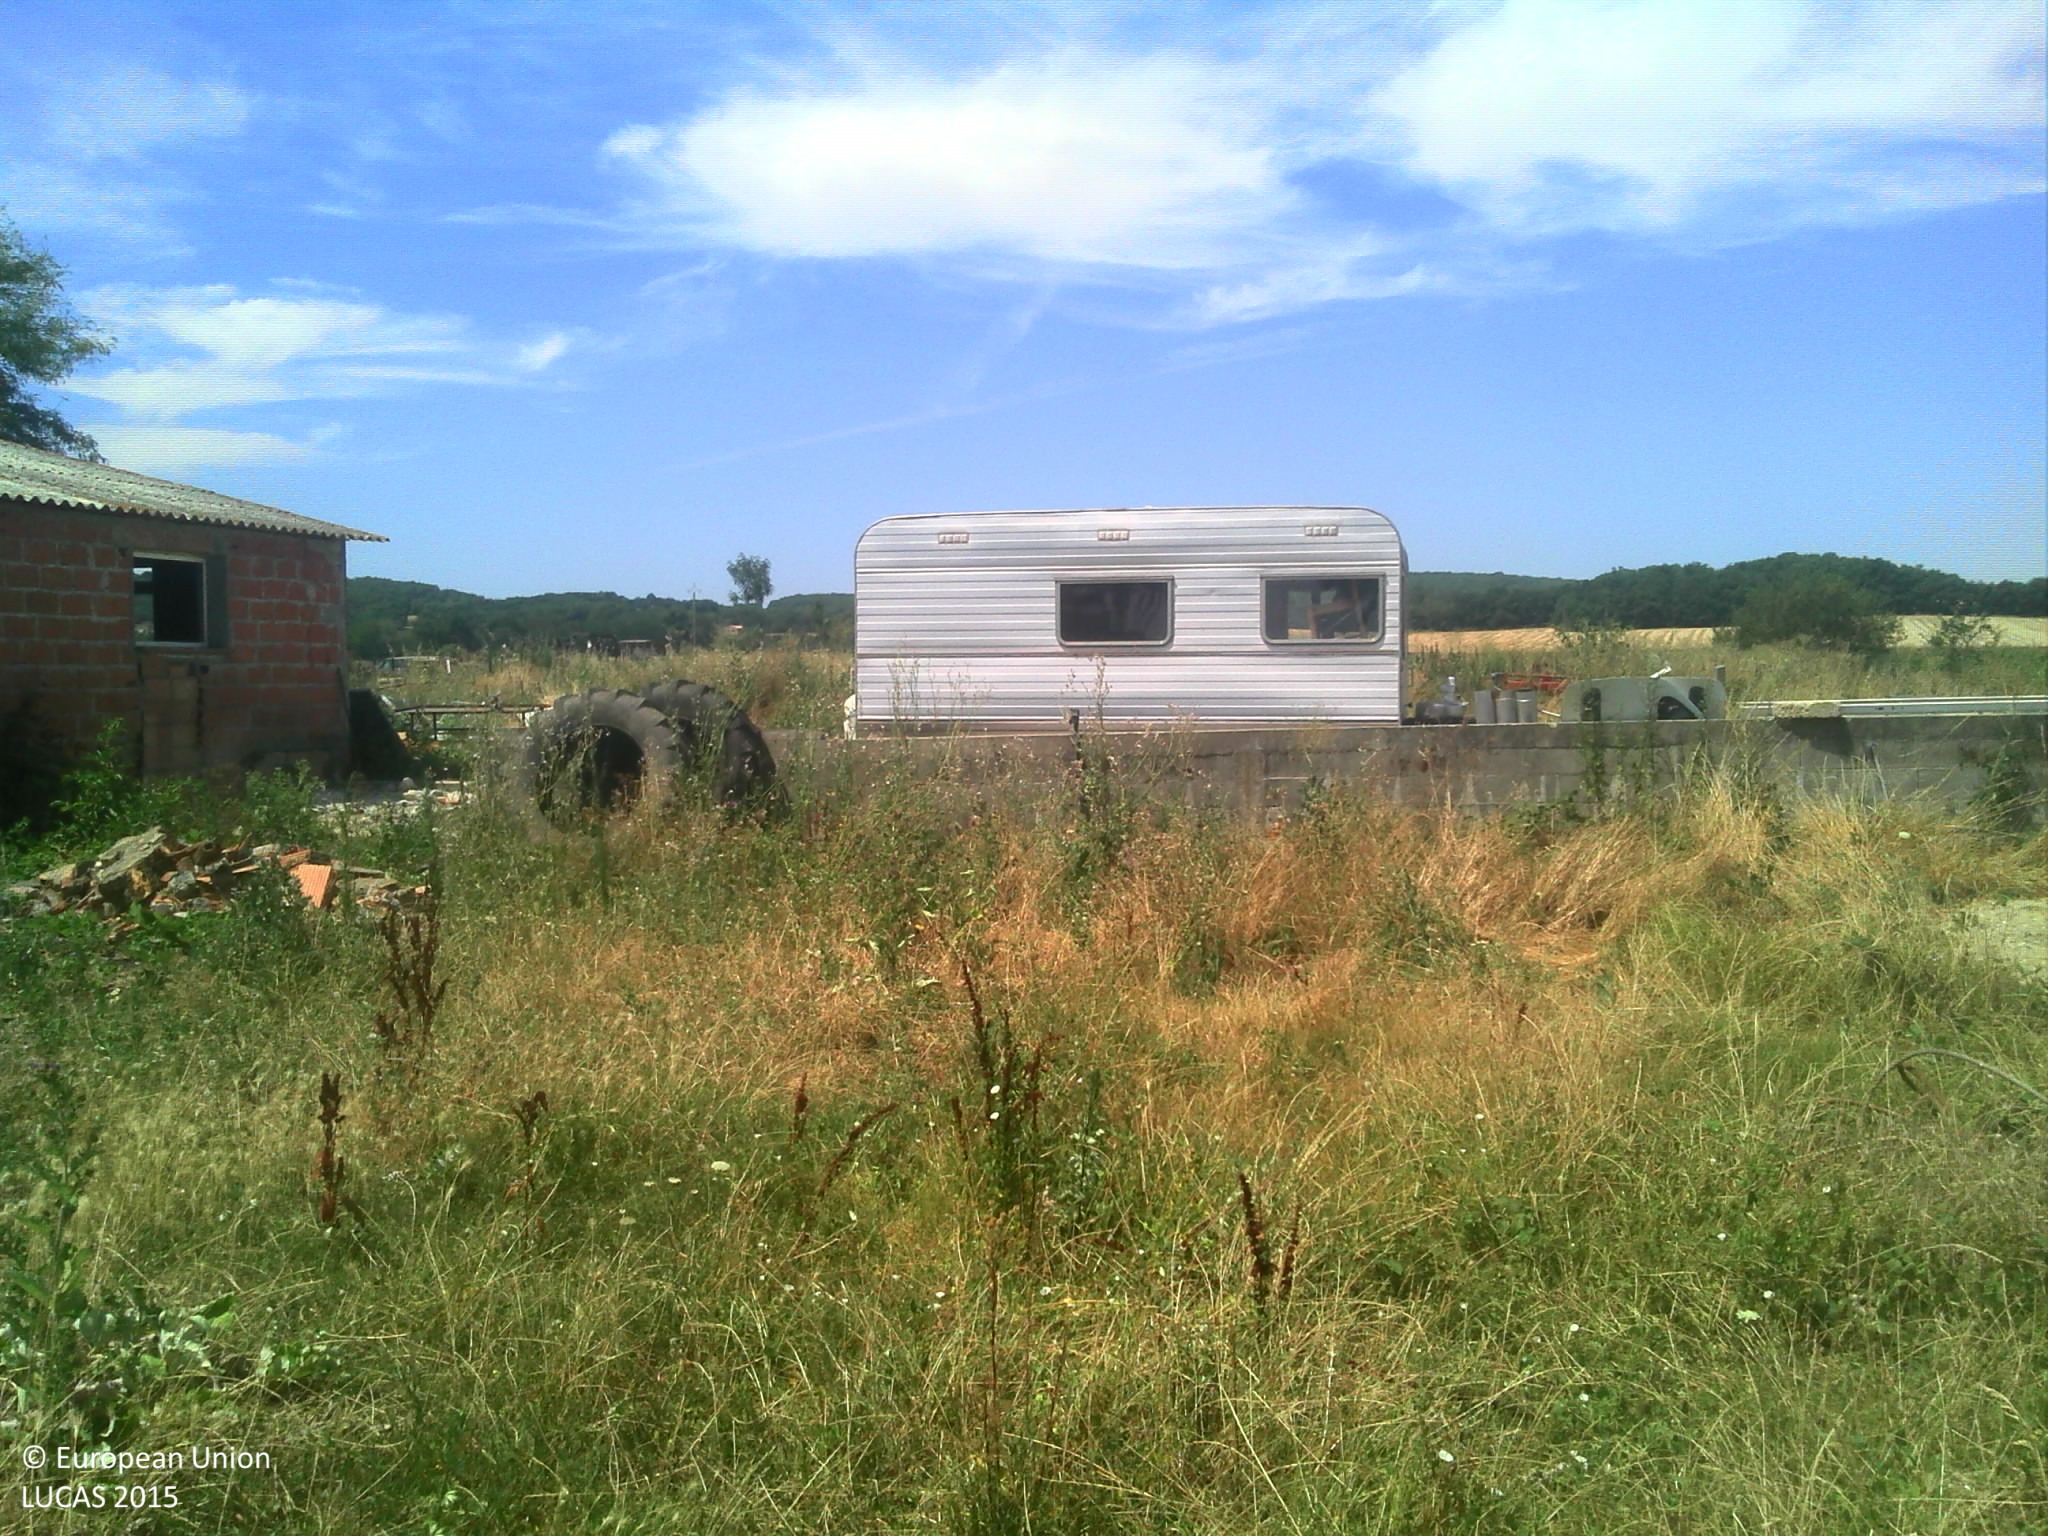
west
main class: Grassland
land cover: Spontaneously vegetated surfaces
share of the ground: > 75 %
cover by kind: herbaceous plants 80 %, consolidated bare surface 20 %
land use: Residential
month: July
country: FR
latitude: 43.4103
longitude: 1.3712
